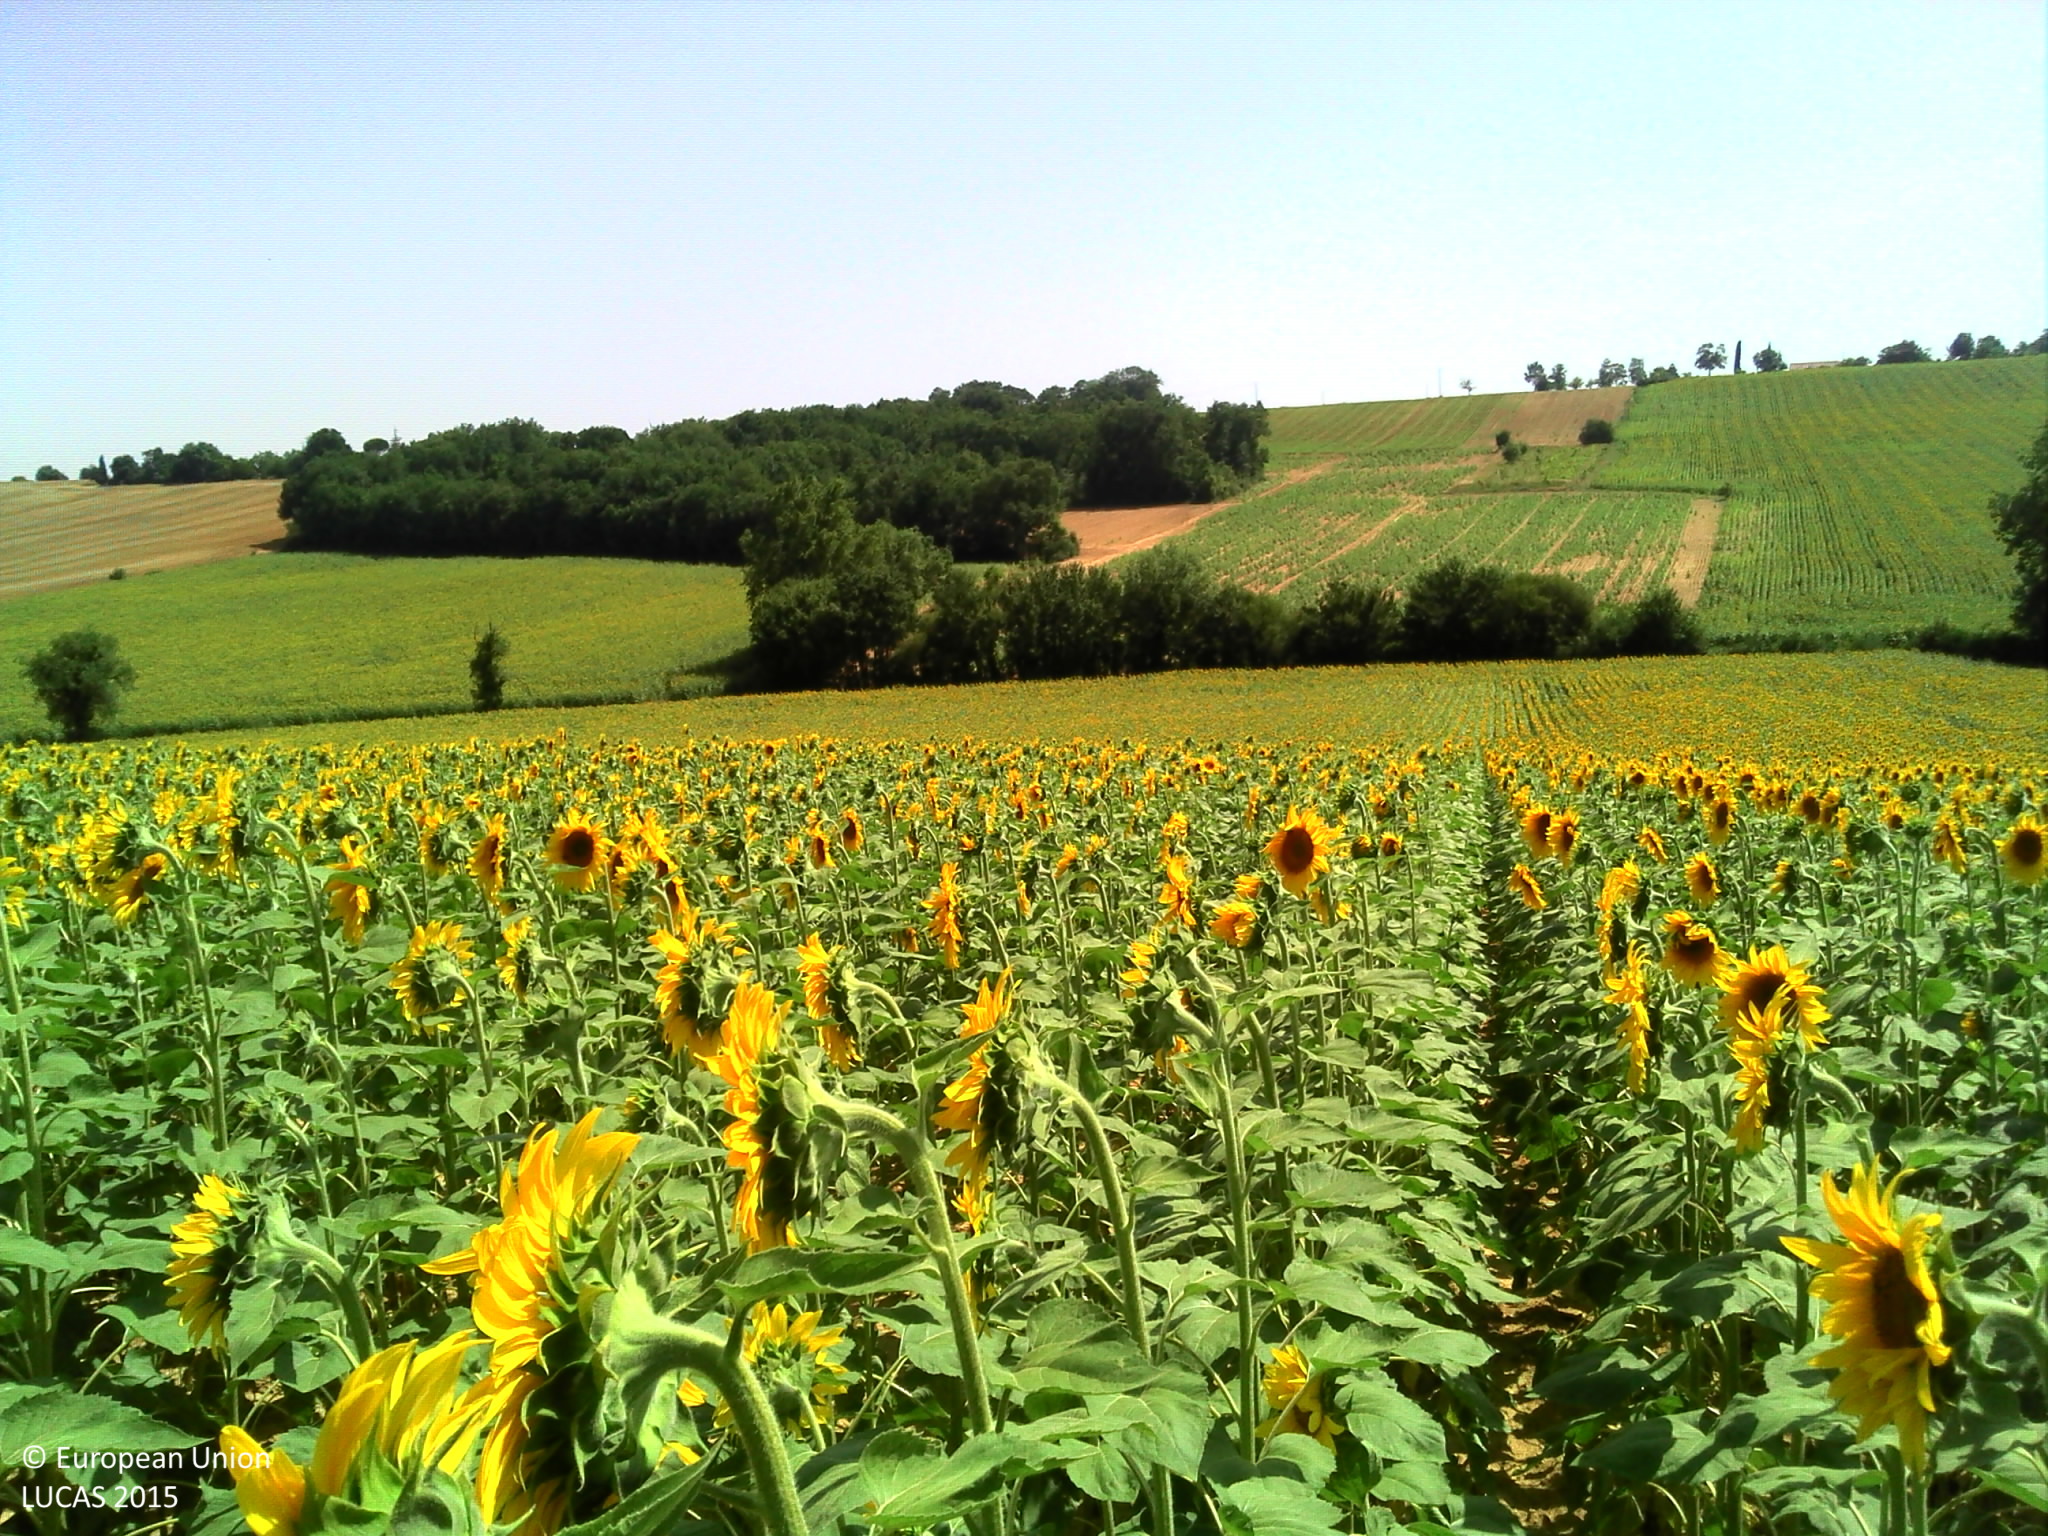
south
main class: Cropland
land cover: Sunflower
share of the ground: > 75 %
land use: Agriculture (excluding fallow land and kitchen gardens)
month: July
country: FR
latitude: 43.5375
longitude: 0.9543
